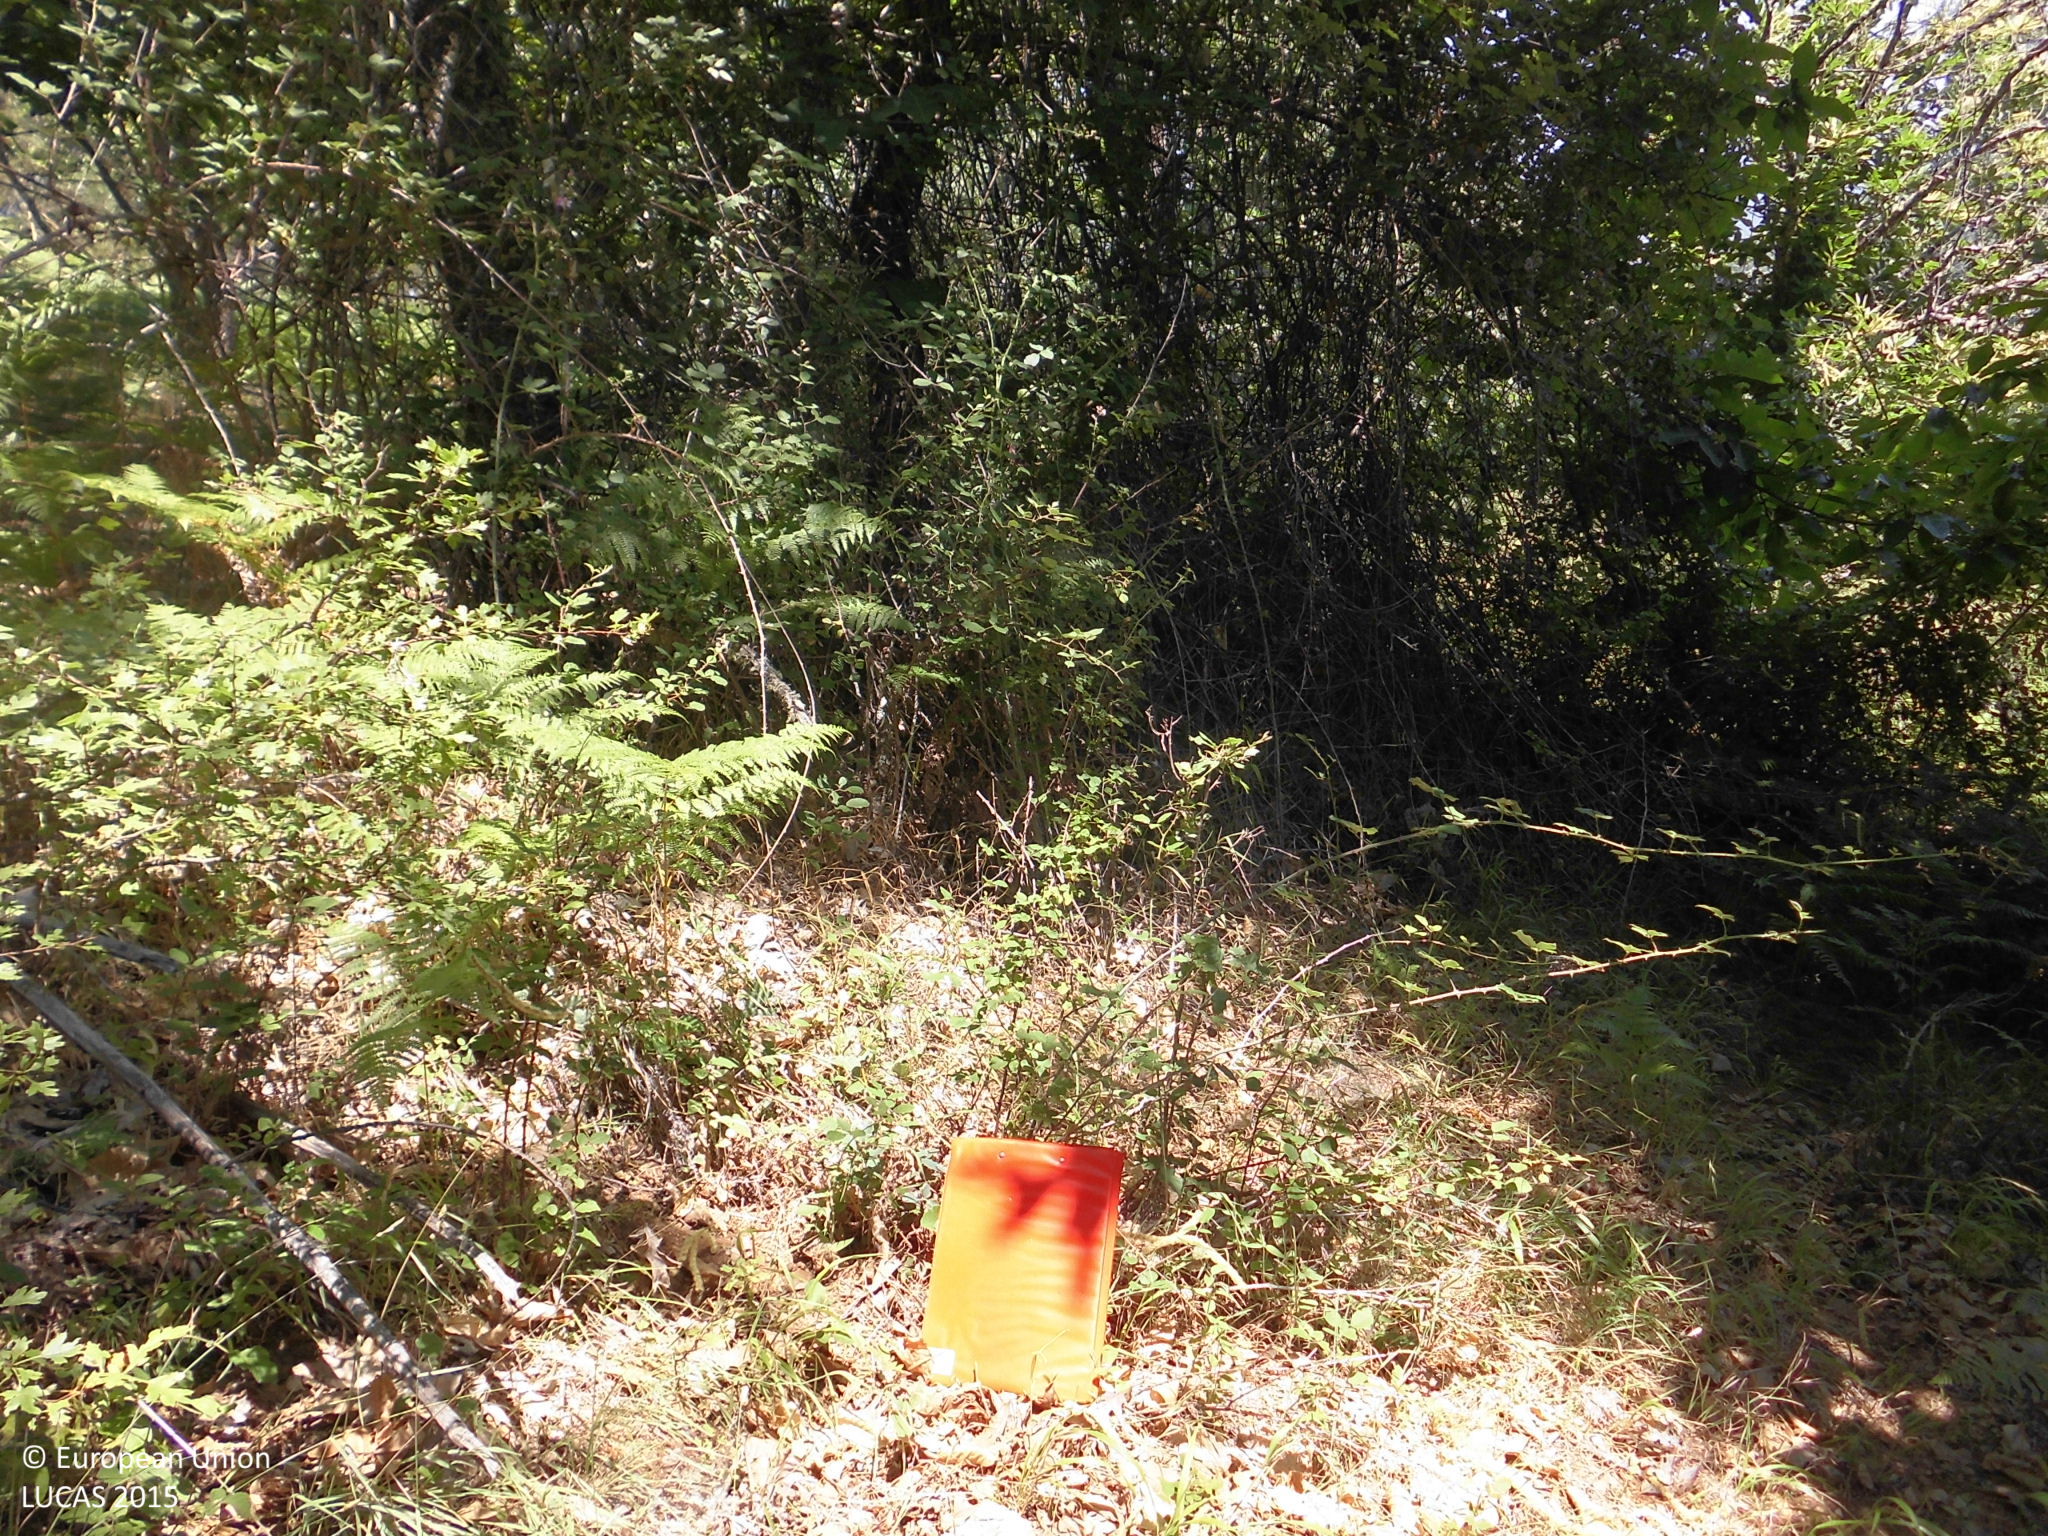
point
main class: Woodland
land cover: Broadleaved woodland
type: thermophilous deciduous forest
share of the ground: > 75 %
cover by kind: broadleaved forest trees 75 %, herbaceous plants 15 %, shrubs 10 %
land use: Forestry
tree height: > 5 m
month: June
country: ES
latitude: 39.5258
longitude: -5.3711
